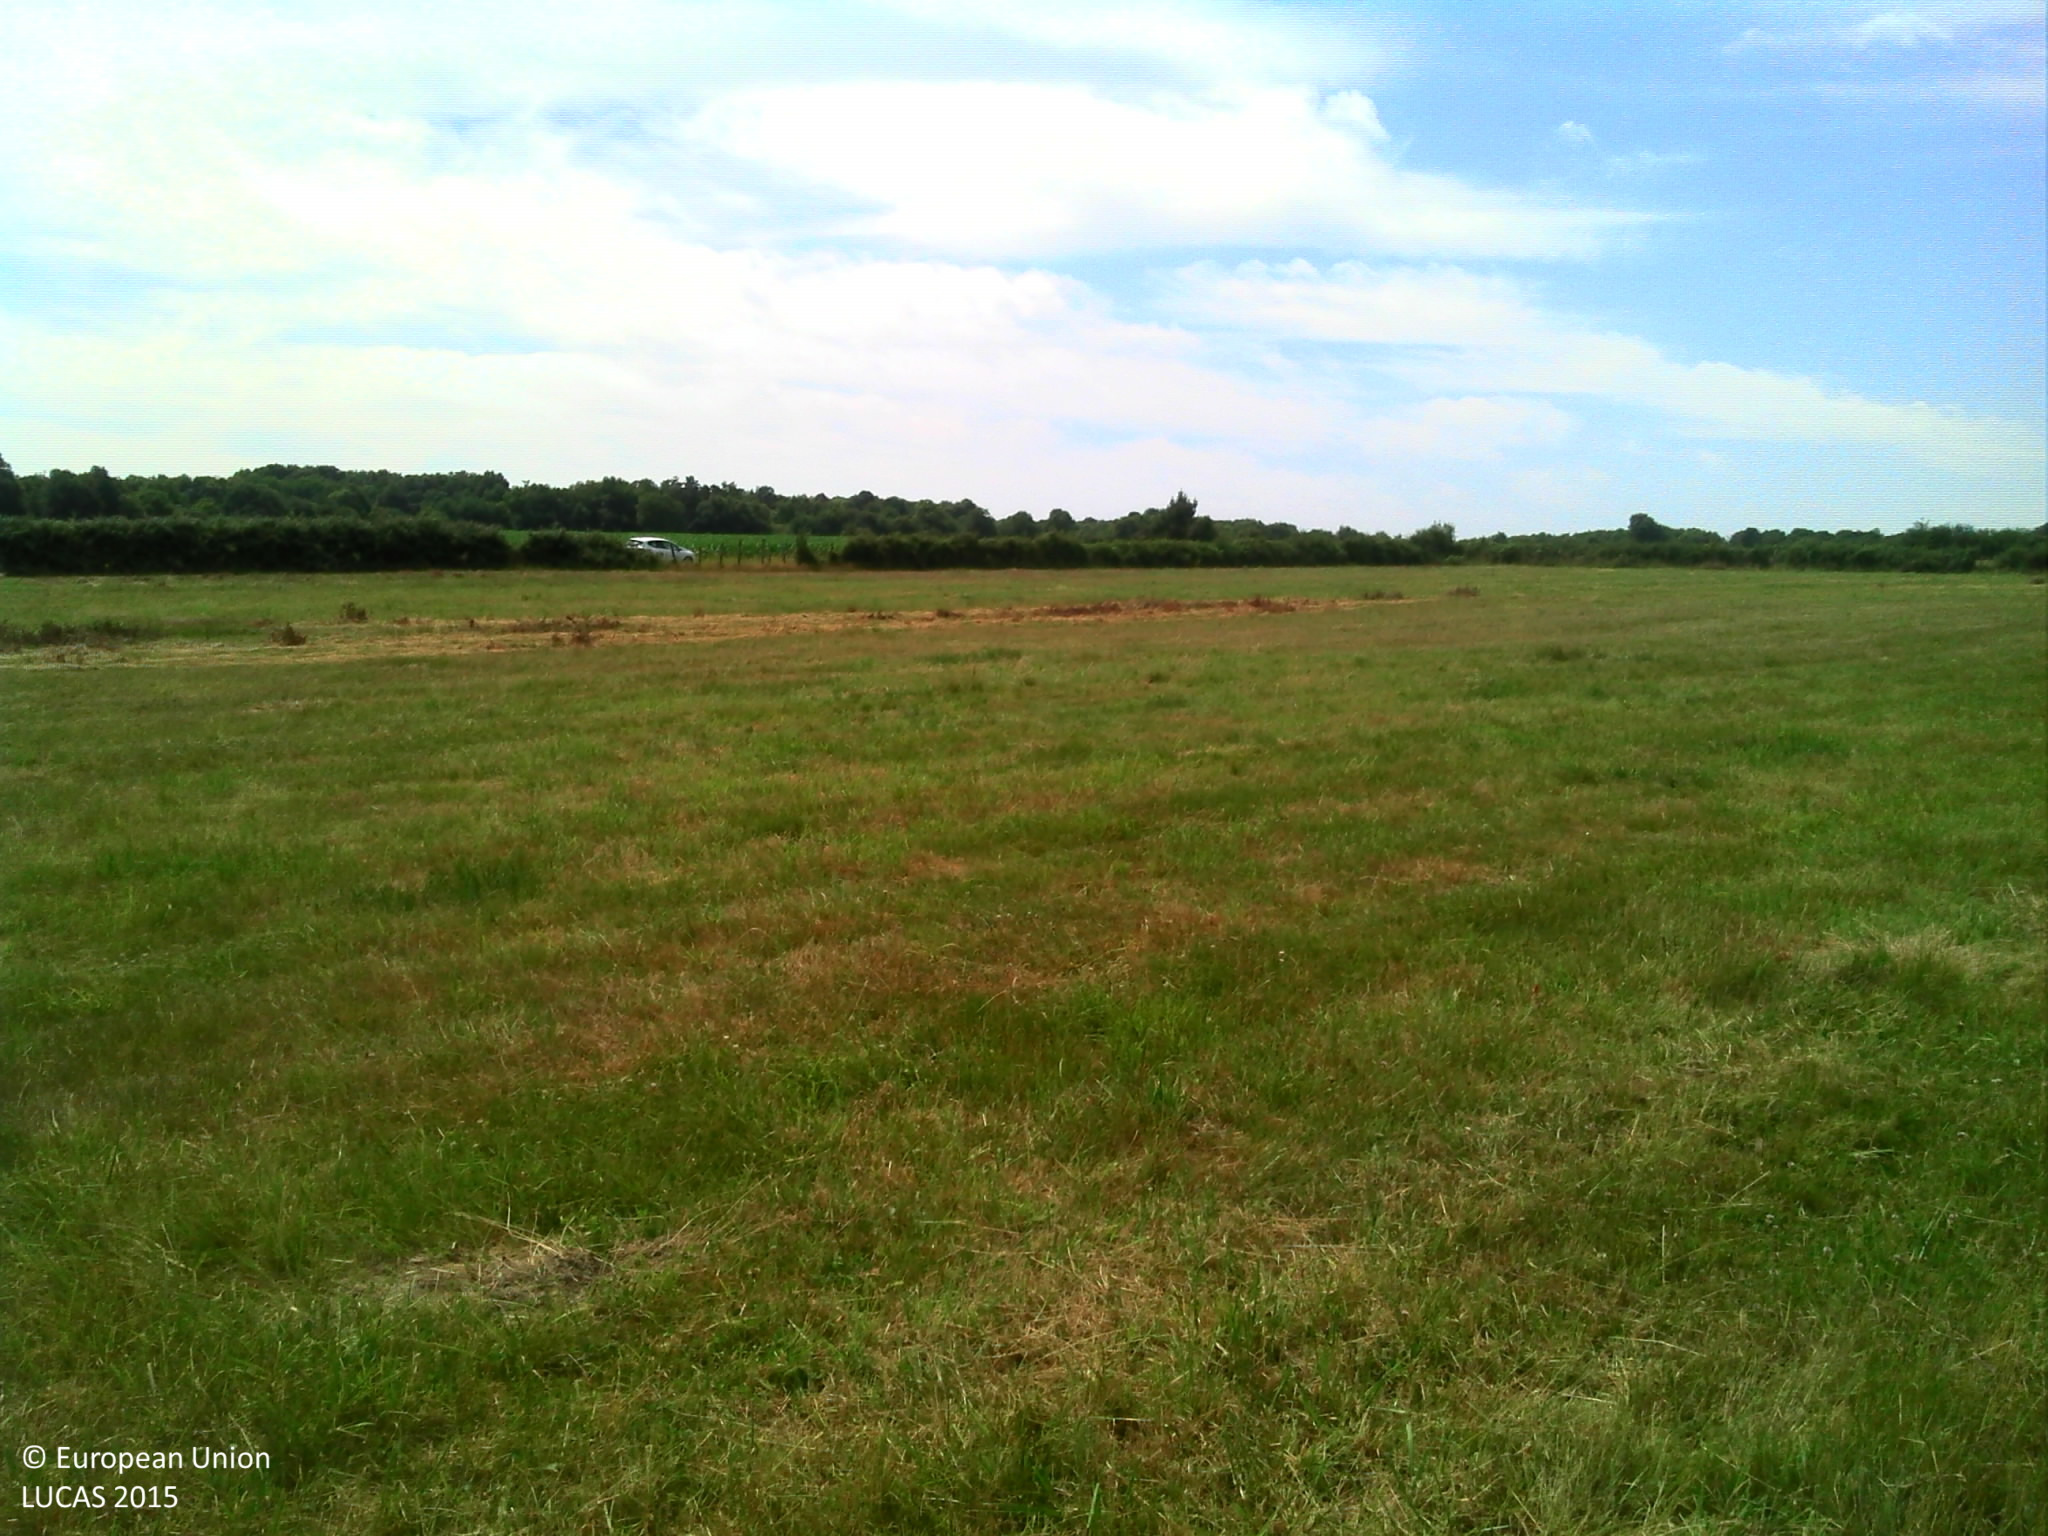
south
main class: Grassland
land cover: Grassland without tree/shrub cover
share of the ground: > 75 %
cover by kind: herbaceous plants 100 %
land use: Agriculture (excluding fallow land and kitchen gardens)
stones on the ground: < 10 %
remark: Harvested field
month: June
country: FR
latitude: 47.5225
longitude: 0.2949
